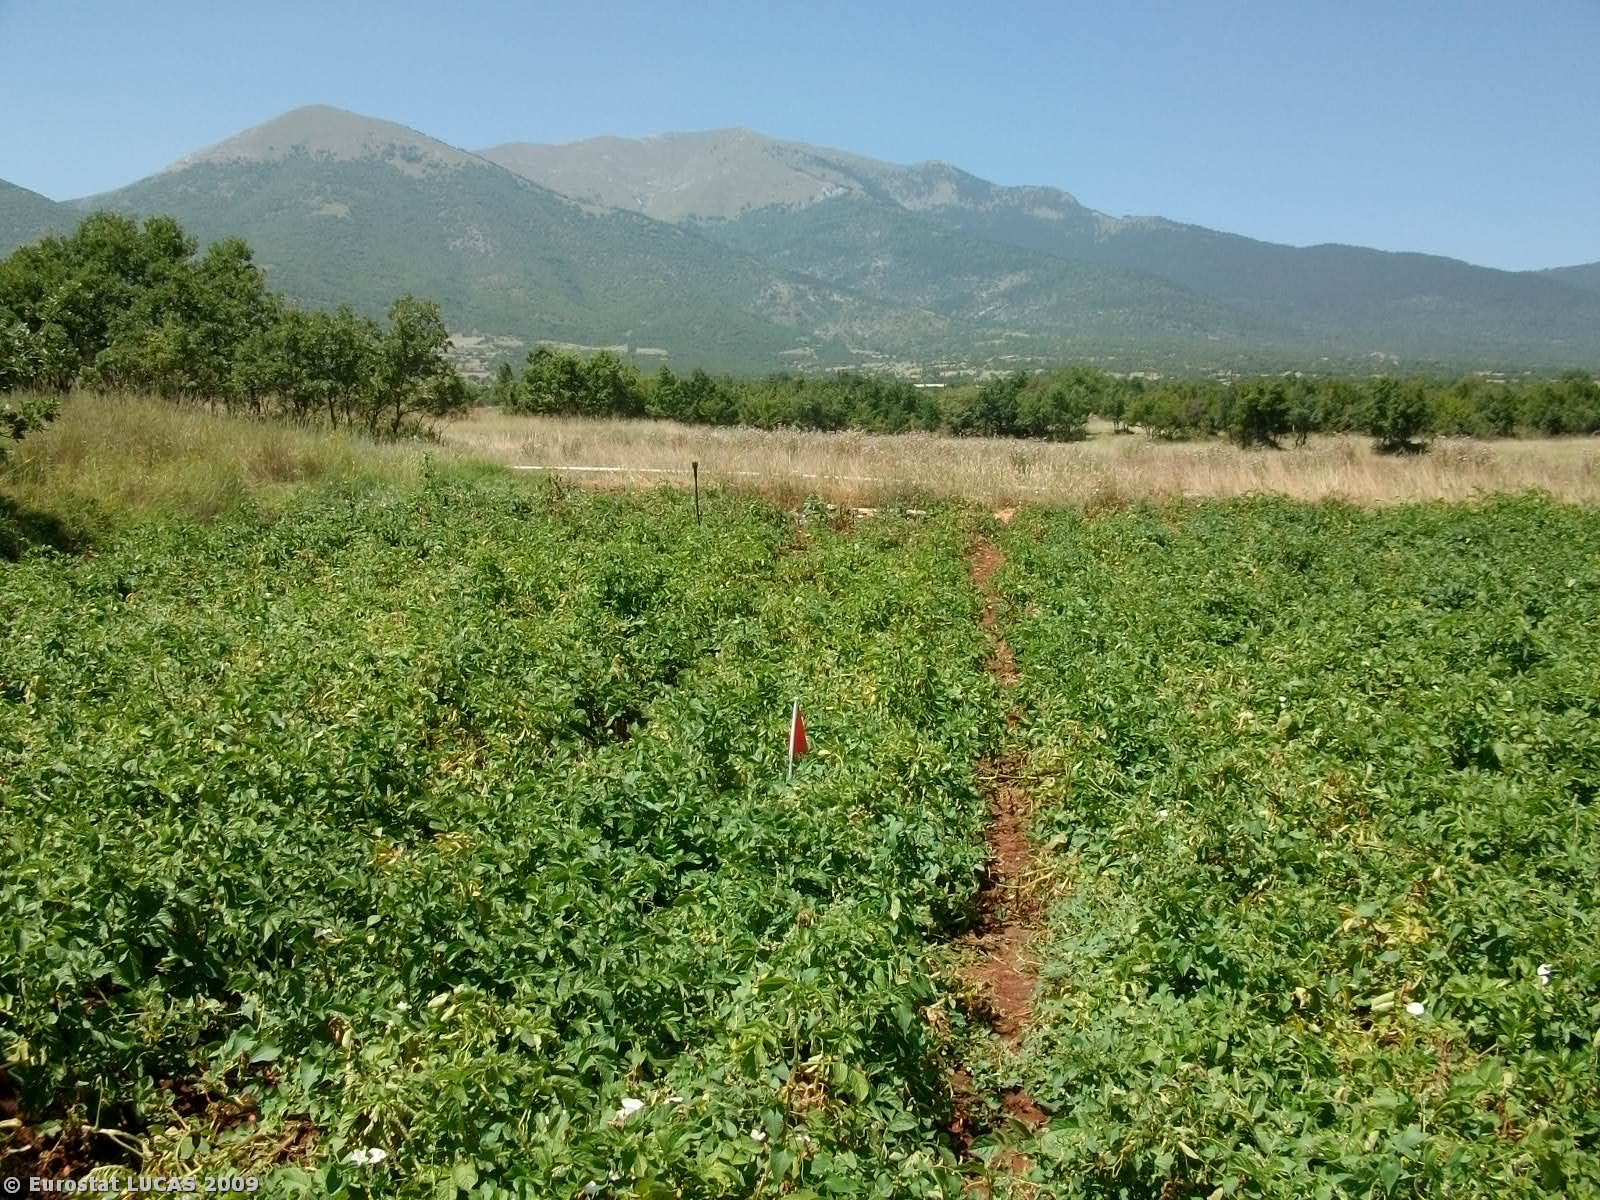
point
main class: Cropland
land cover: Potatoes
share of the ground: > 75 %
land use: Agriculture (excluding fallow land and kitchen gardens)
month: July
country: GR
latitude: 41.3685
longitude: 23.7145
